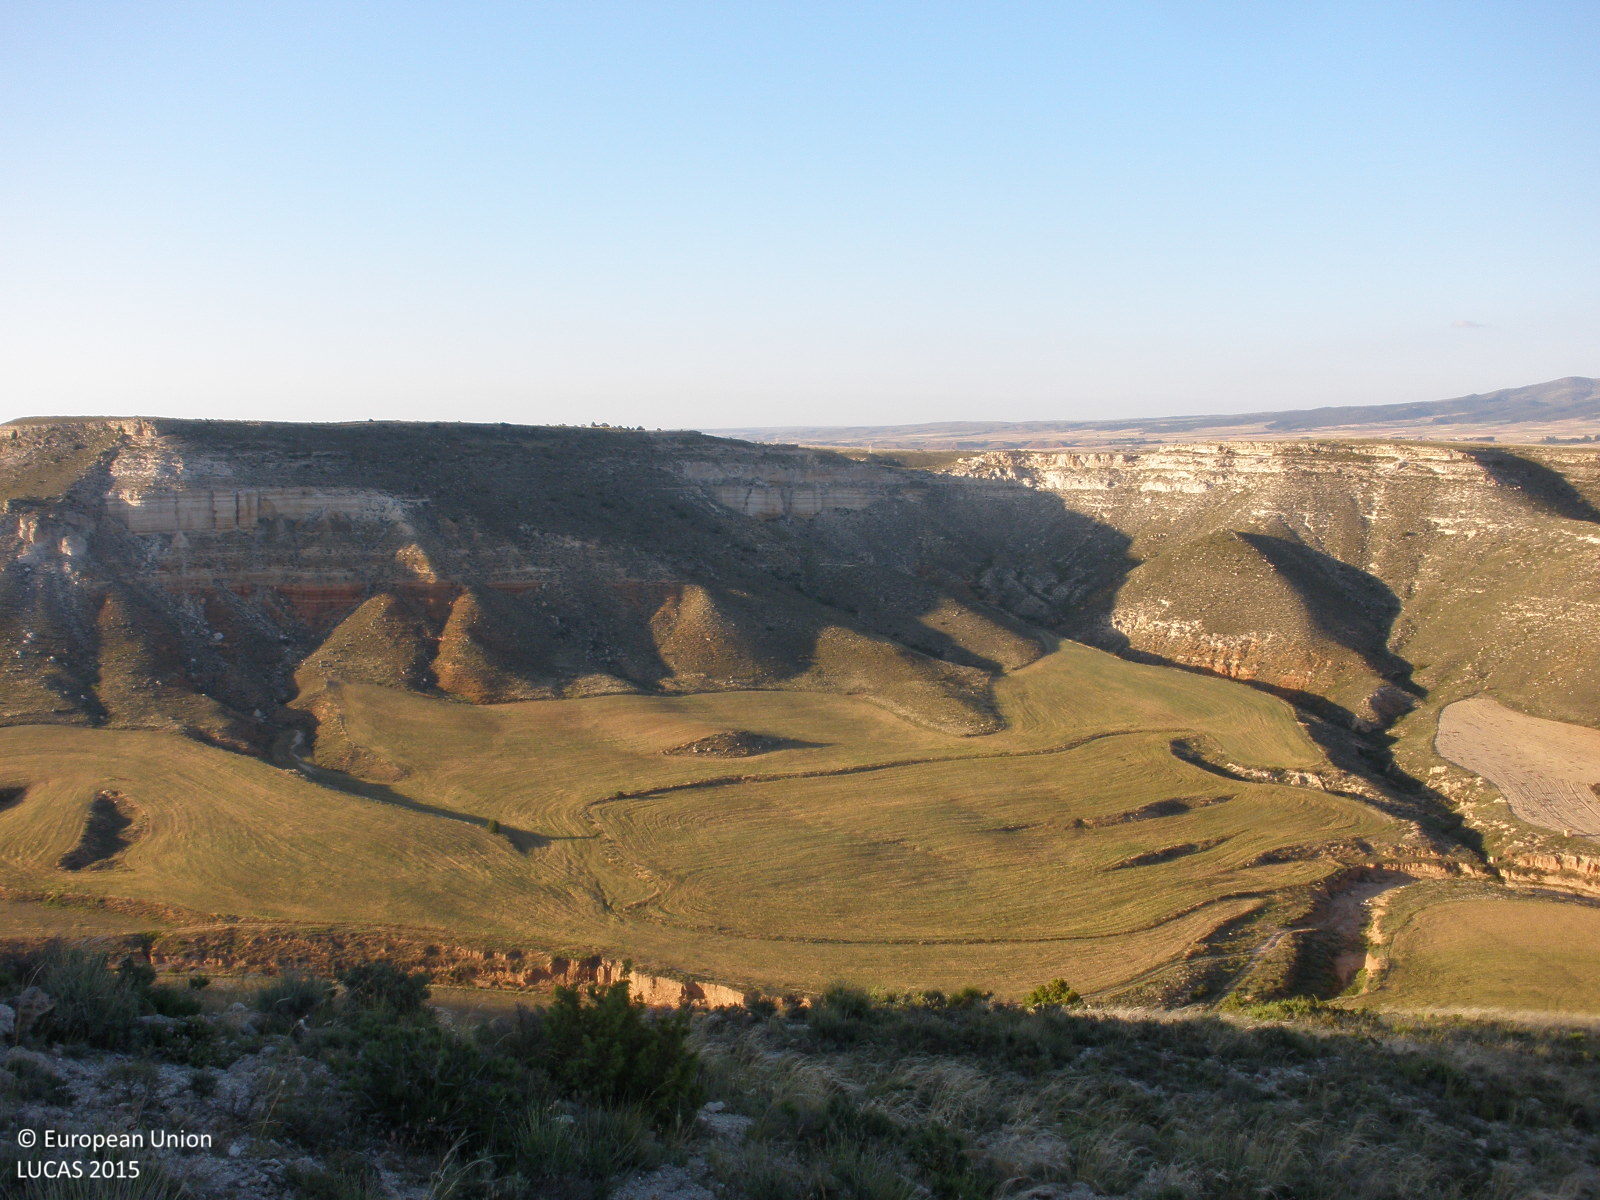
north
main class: Shrubland
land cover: Shrubland without tree cover
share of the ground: 25 - 50 %
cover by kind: shrubs 40 %, herbaceous plants 30 %, consolidated bare surface 30 %
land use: Agriculture (excluding fallow land and kitchen gardens)
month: June
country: ES
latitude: 40.4991
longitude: -1.0444
